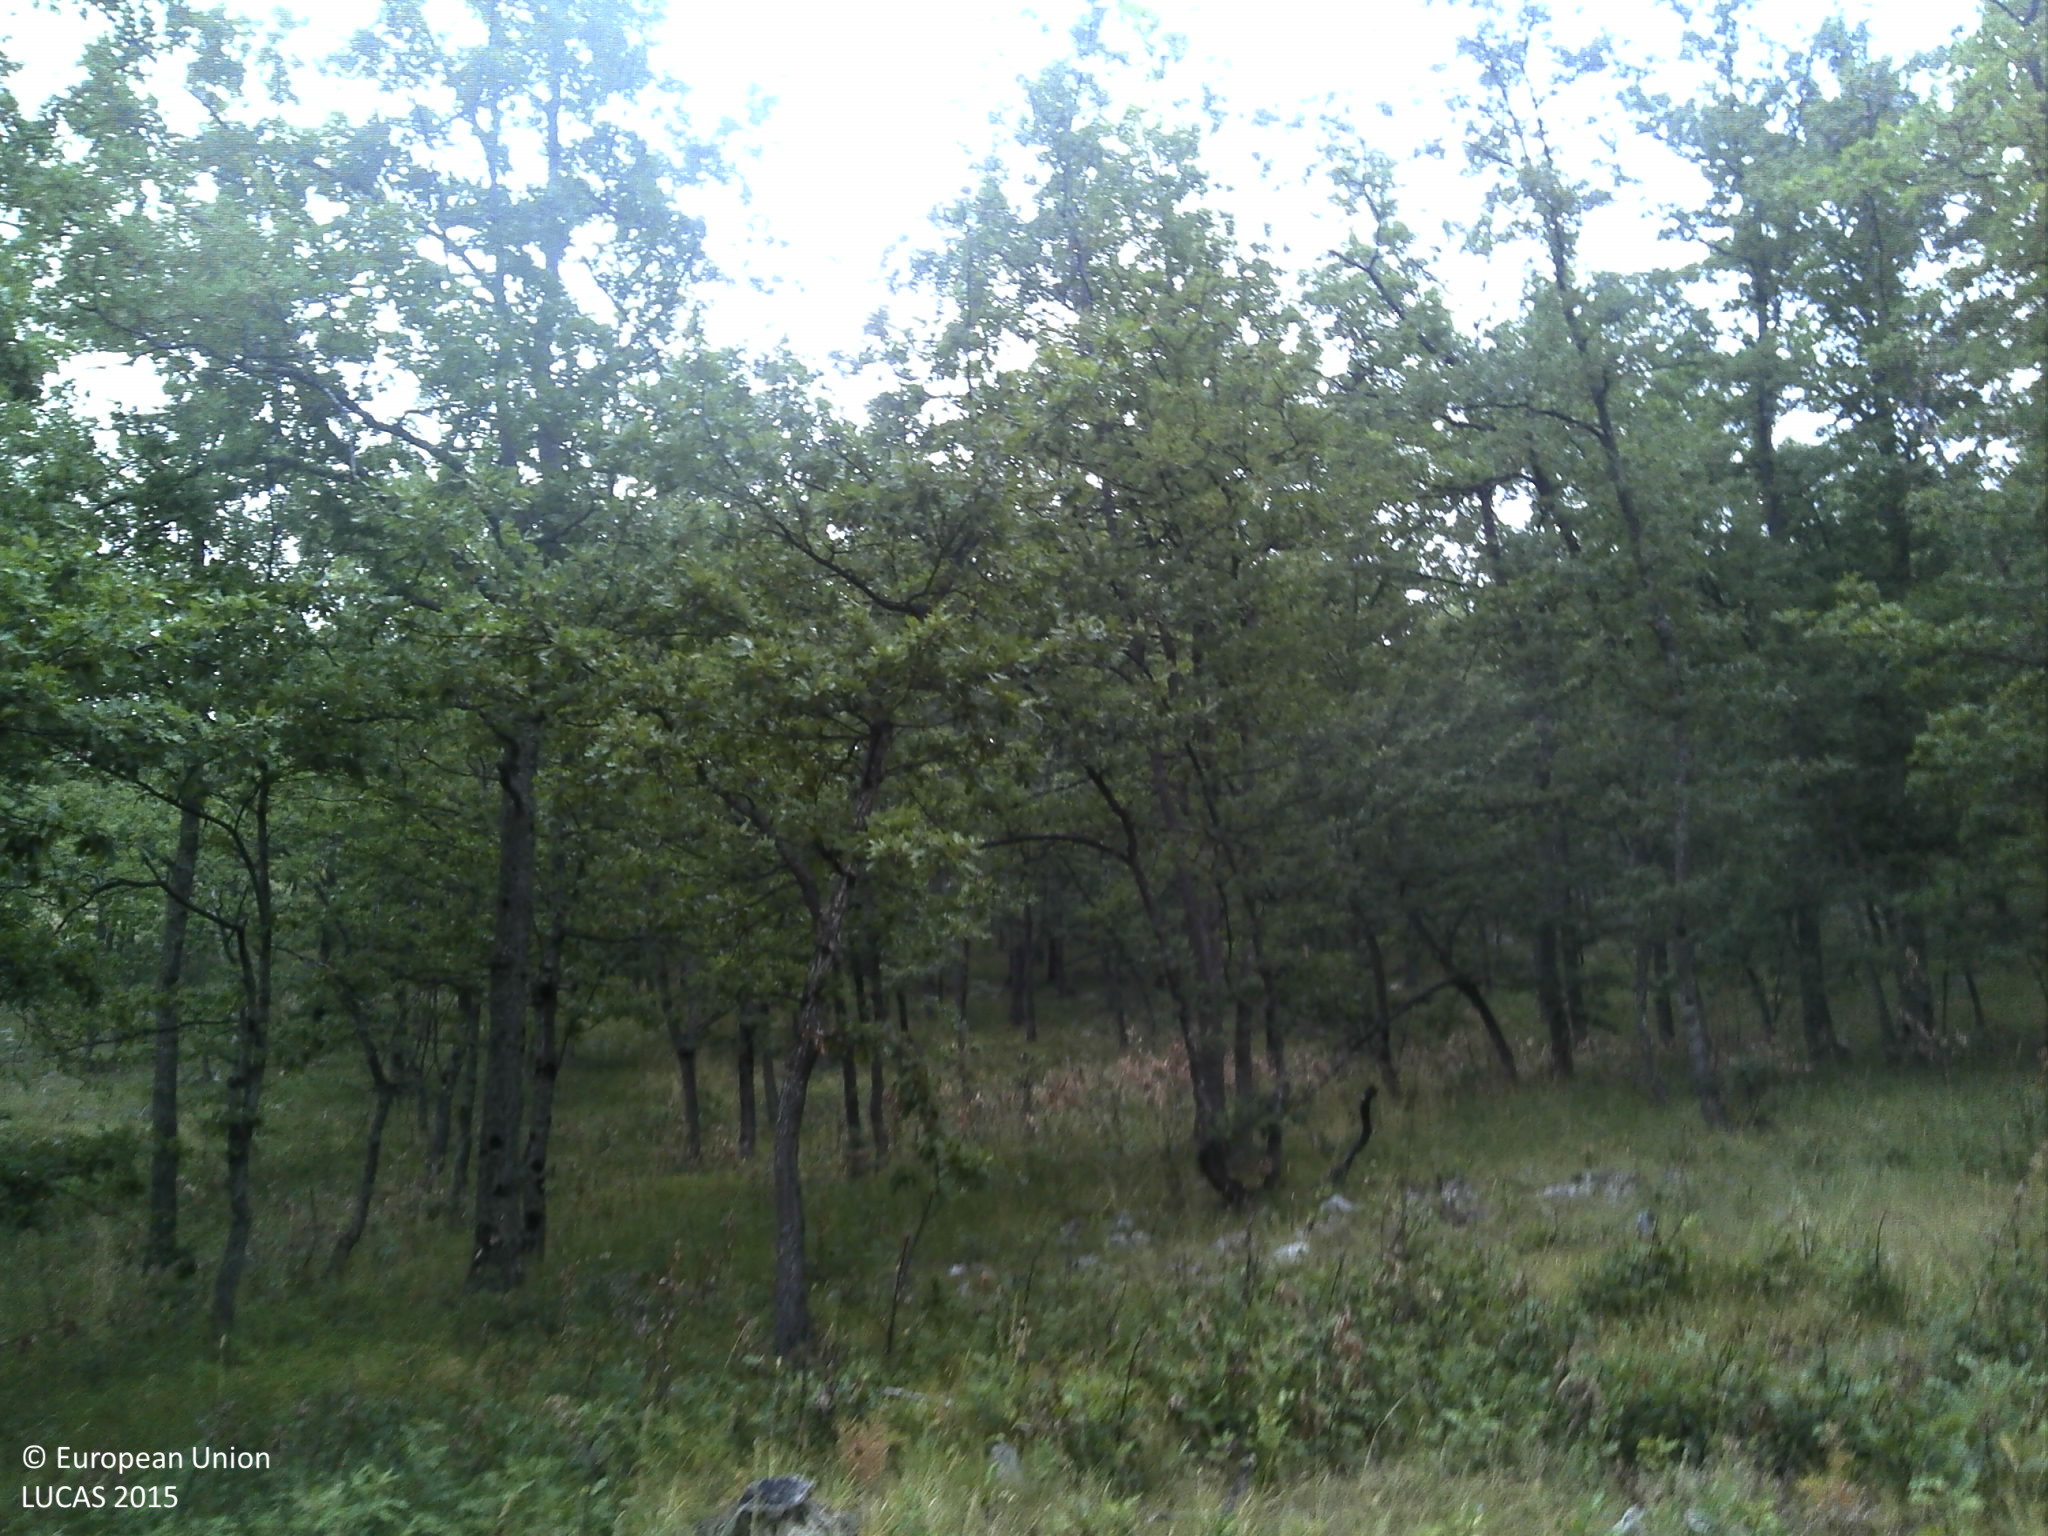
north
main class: Woodland
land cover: Broadleaved woodland
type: beech forest
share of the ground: 50 - 75 %
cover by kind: broadleaved forest trees 50 %, herbaceous plants 40 %, shrubs 10 %
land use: Semi-natural and natural areas not in use
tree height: > 5 m
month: July
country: HR
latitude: 44.4265
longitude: 16.0608
